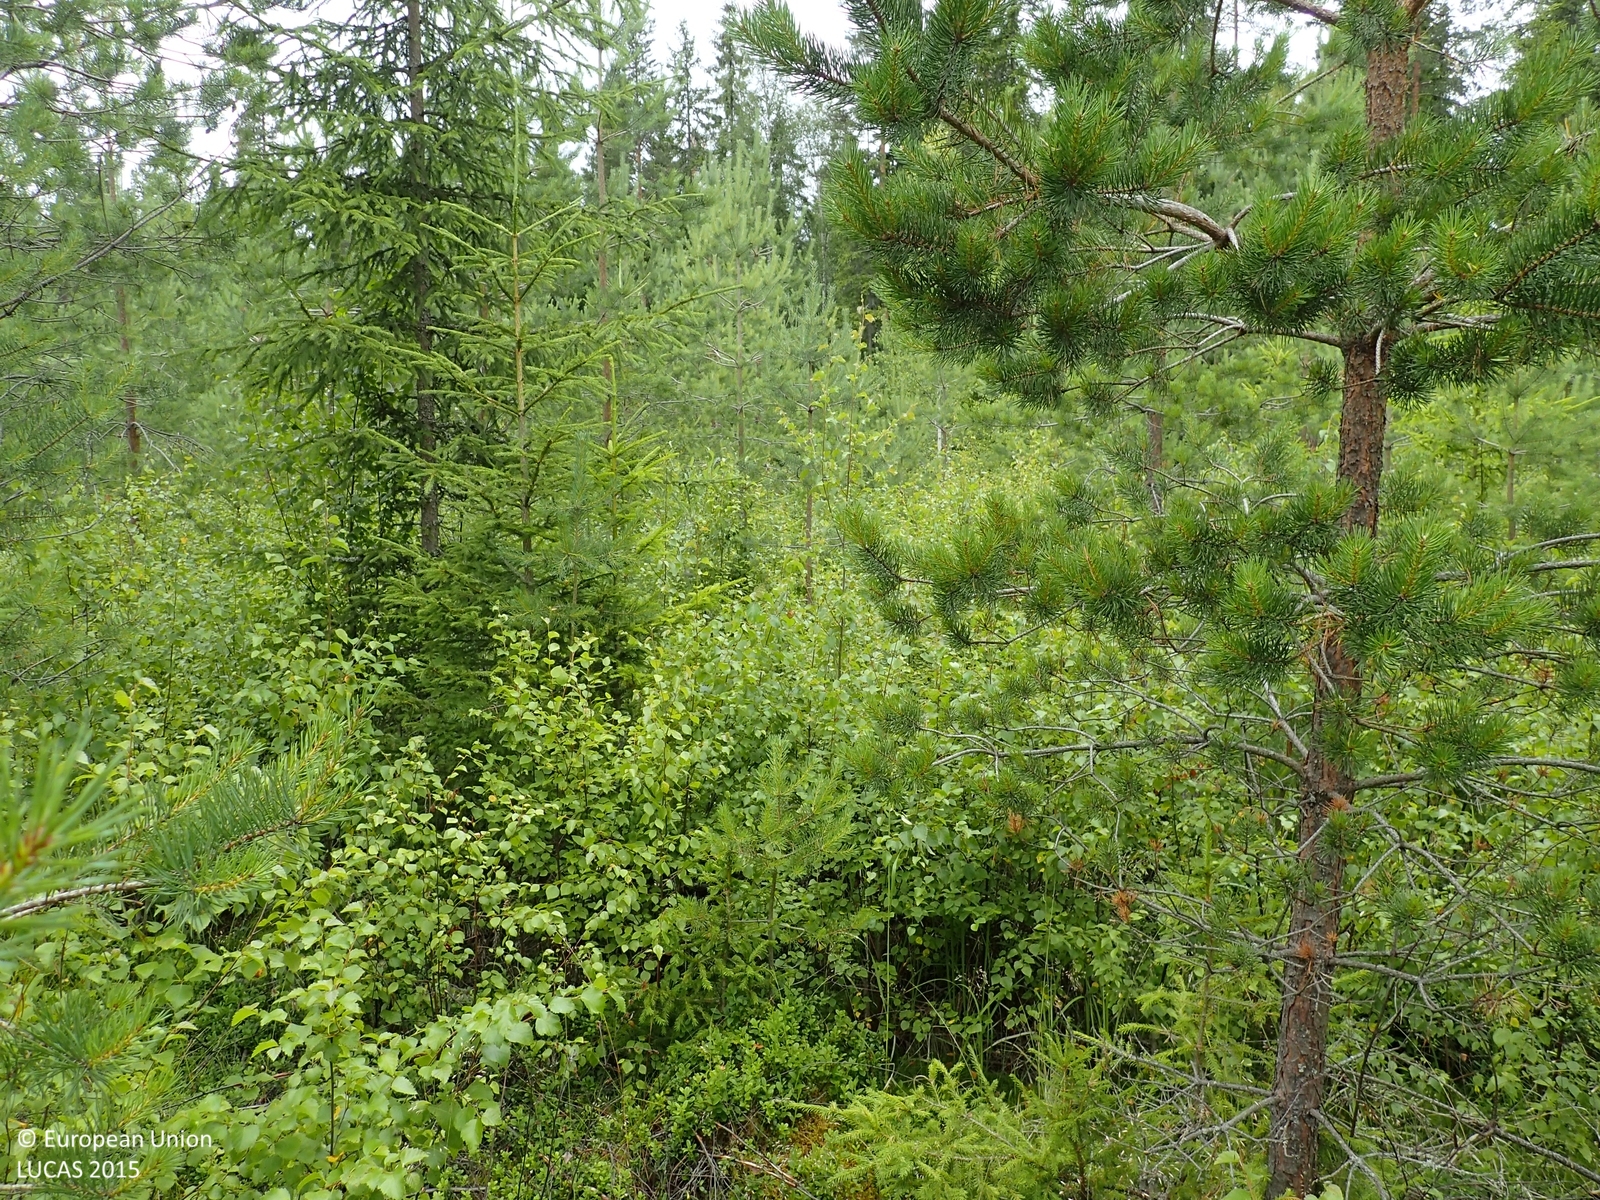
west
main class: Woodland
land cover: Pine dominated mixed woodland
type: boreal forest
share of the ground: > 75 %
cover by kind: coniferous forest trees 55 %, shrubs 25 %, broadleaved forest trees 20 %
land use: Forestry
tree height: < 5 m
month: July
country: FI
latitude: 62.8810
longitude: 23.2981
